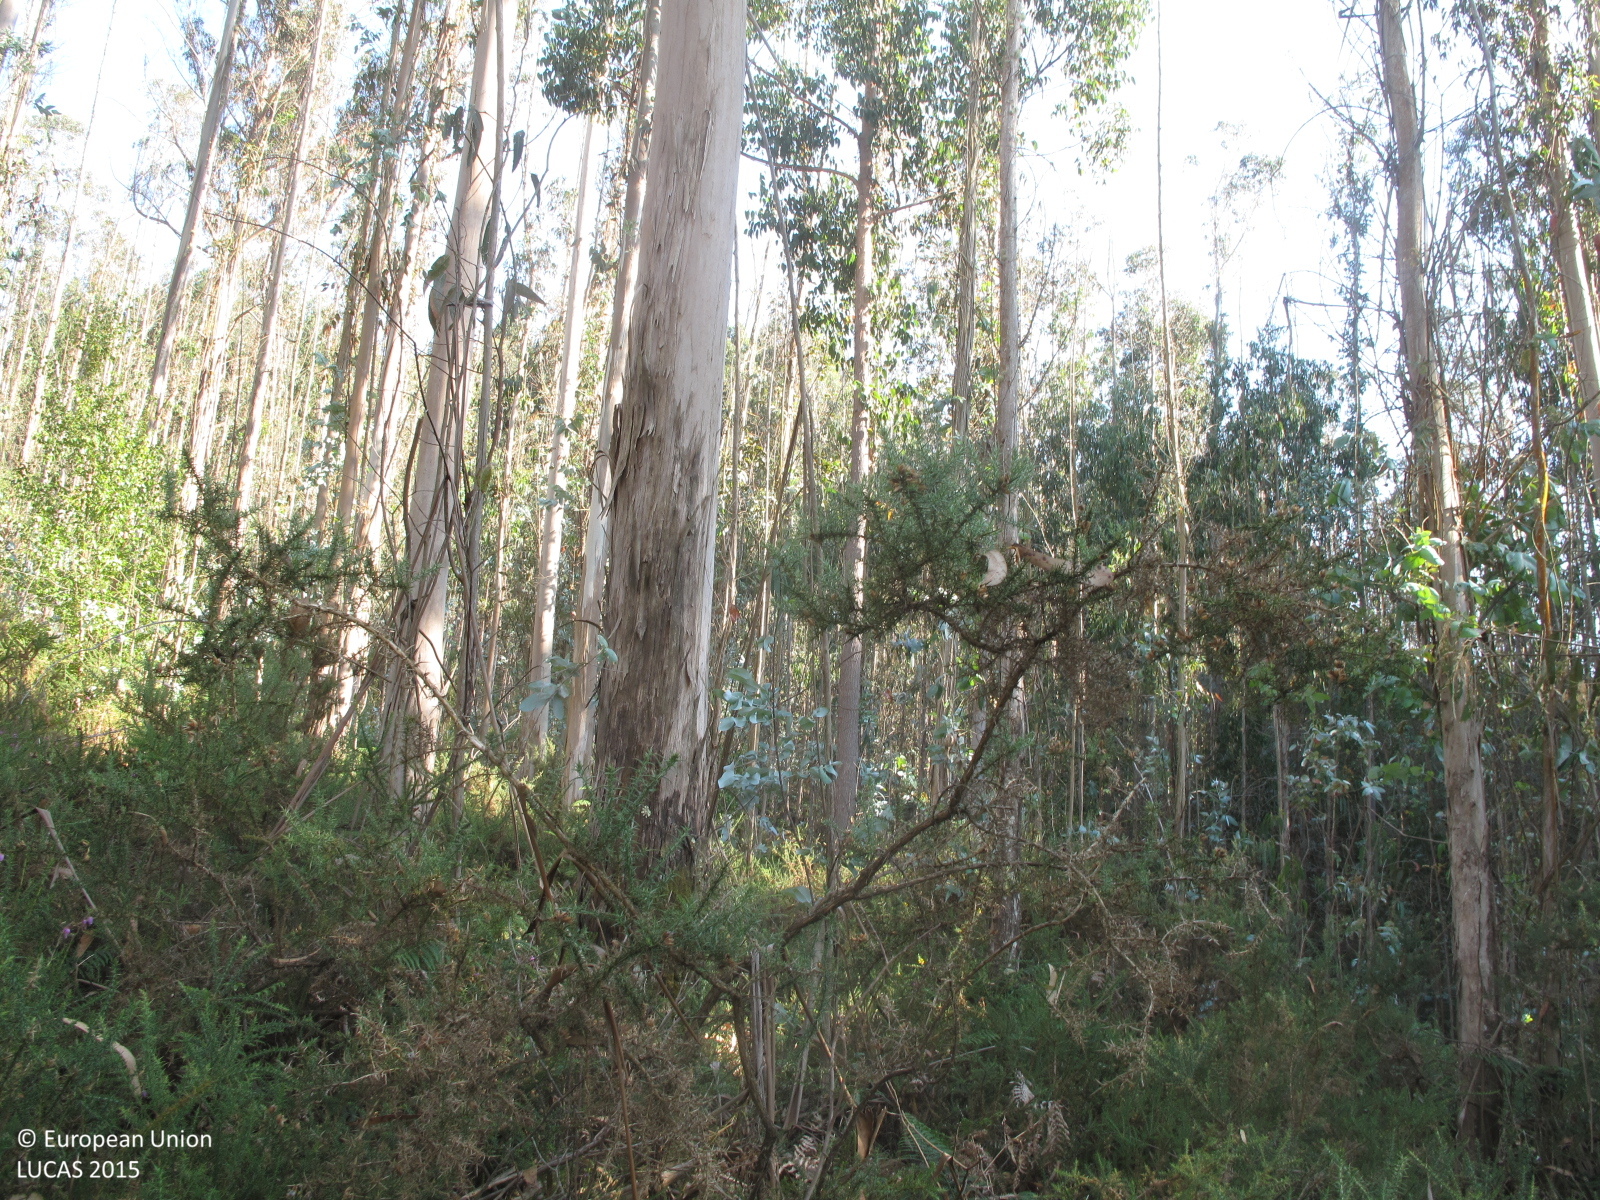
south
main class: Woodland
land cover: Broadleaved woodland
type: exotic forest
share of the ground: 25 - 50 %
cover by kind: shrubs 60 %, broadleaved forest trees 30 %, herbaceous plants 10 %
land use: Forestry
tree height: > 5 m
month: July
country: ES
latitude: 43.3169
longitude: -8.0863
